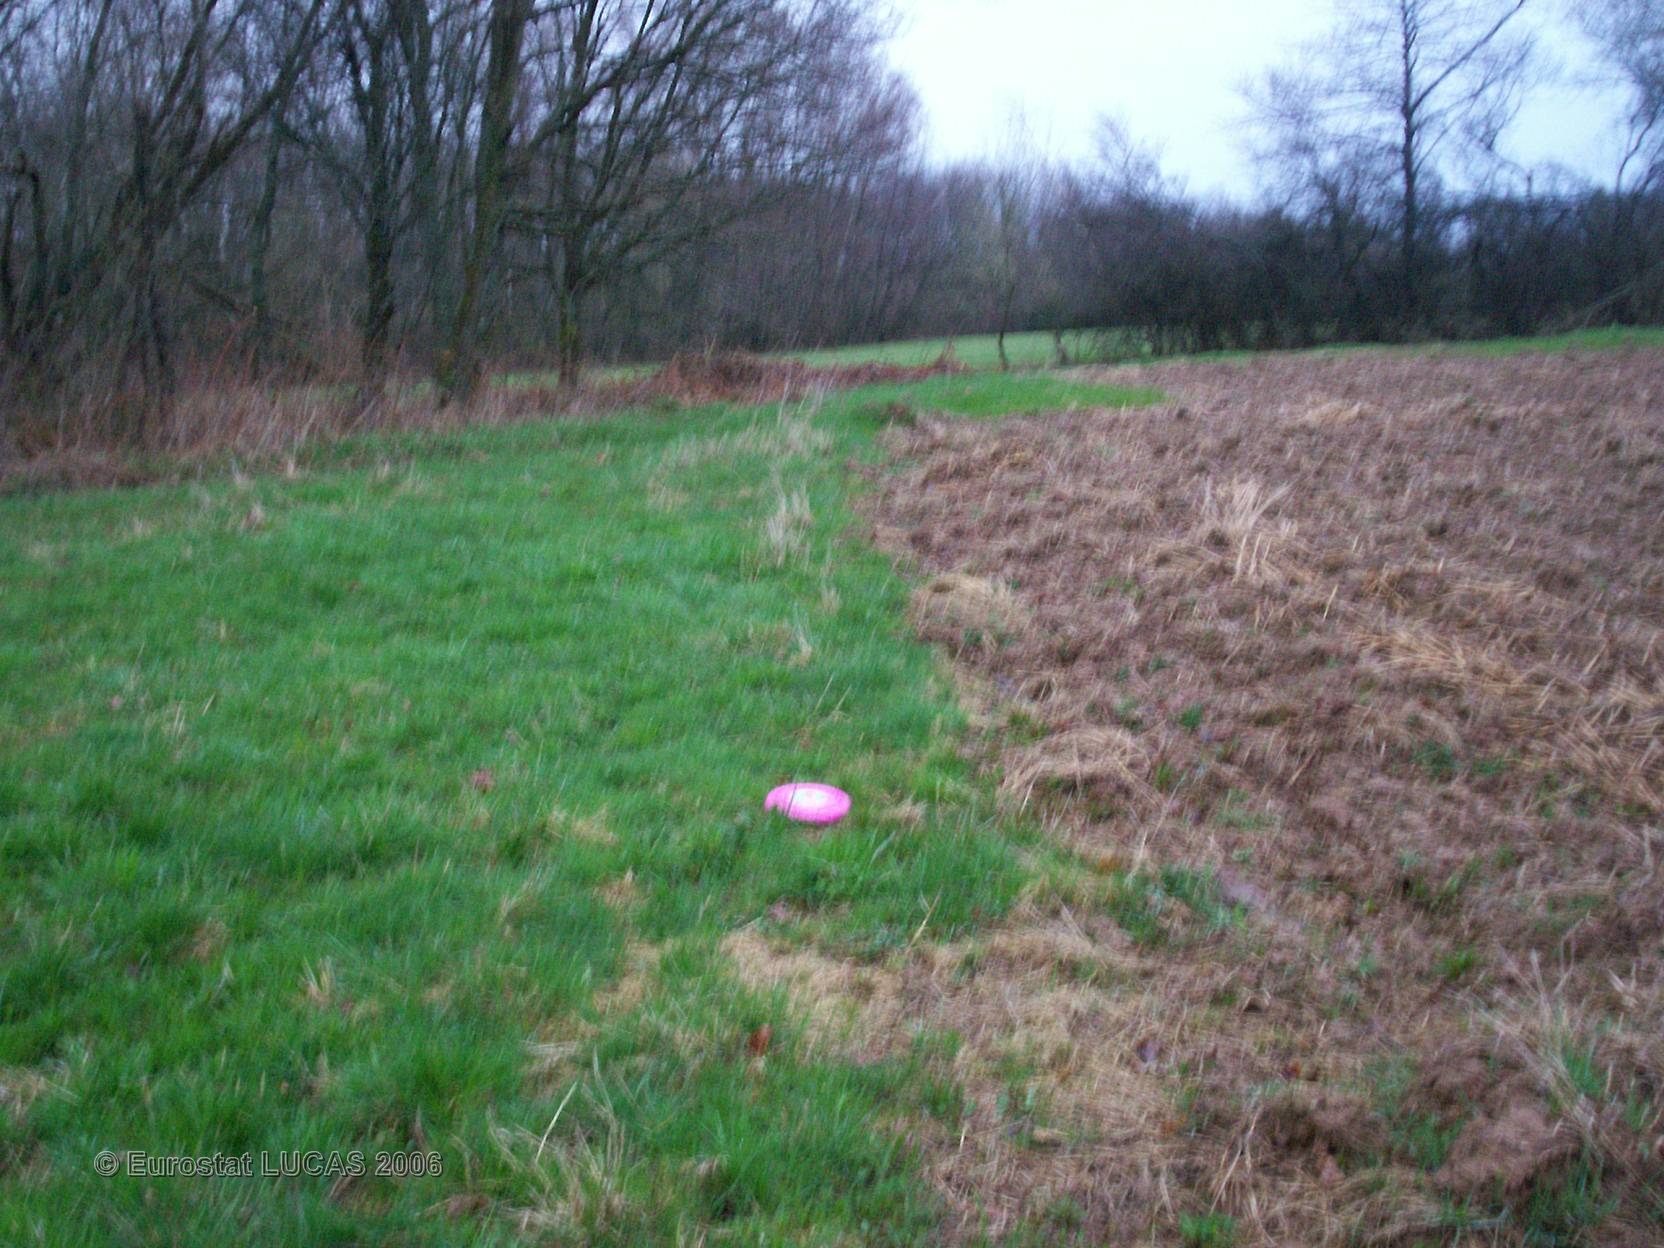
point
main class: Grassland
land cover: Grassland without tree/shrub cover
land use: Agriculture (excluding fallow land and kitchen gardens)
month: April
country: FR
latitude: 47.6122
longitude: 6.5825
